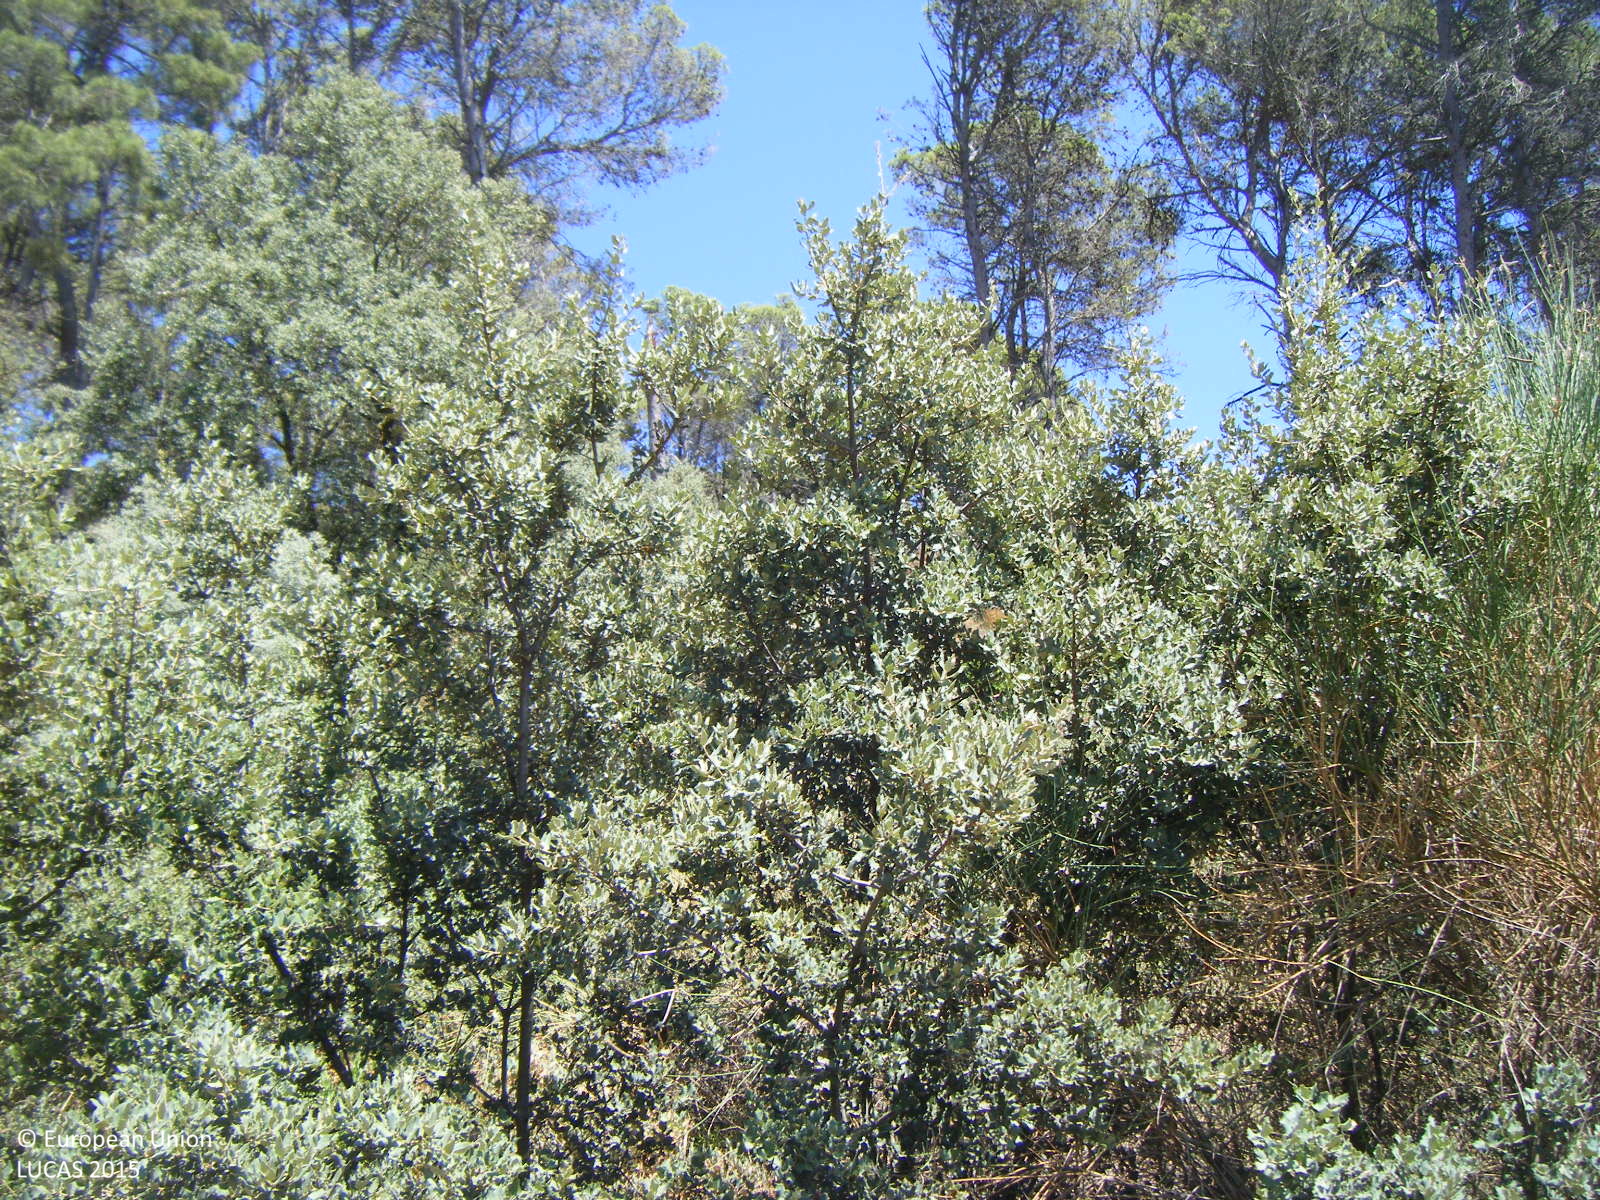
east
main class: Woodland
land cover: Pine dominated coniferous woodland
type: coniferous forest of the mediterranean region
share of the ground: 10 - 25 %
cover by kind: shrubs 80 %, coniferous forest trees 20 %
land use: Forestry
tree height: > 5 m
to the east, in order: Pine dominated coniferous woodland; Paved roads, cycling and walking lanes; Pine dominated coniferous woodland; Grassland without tree/shrub cover
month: July
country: ES
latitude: 36.8150
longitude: -4.3733
